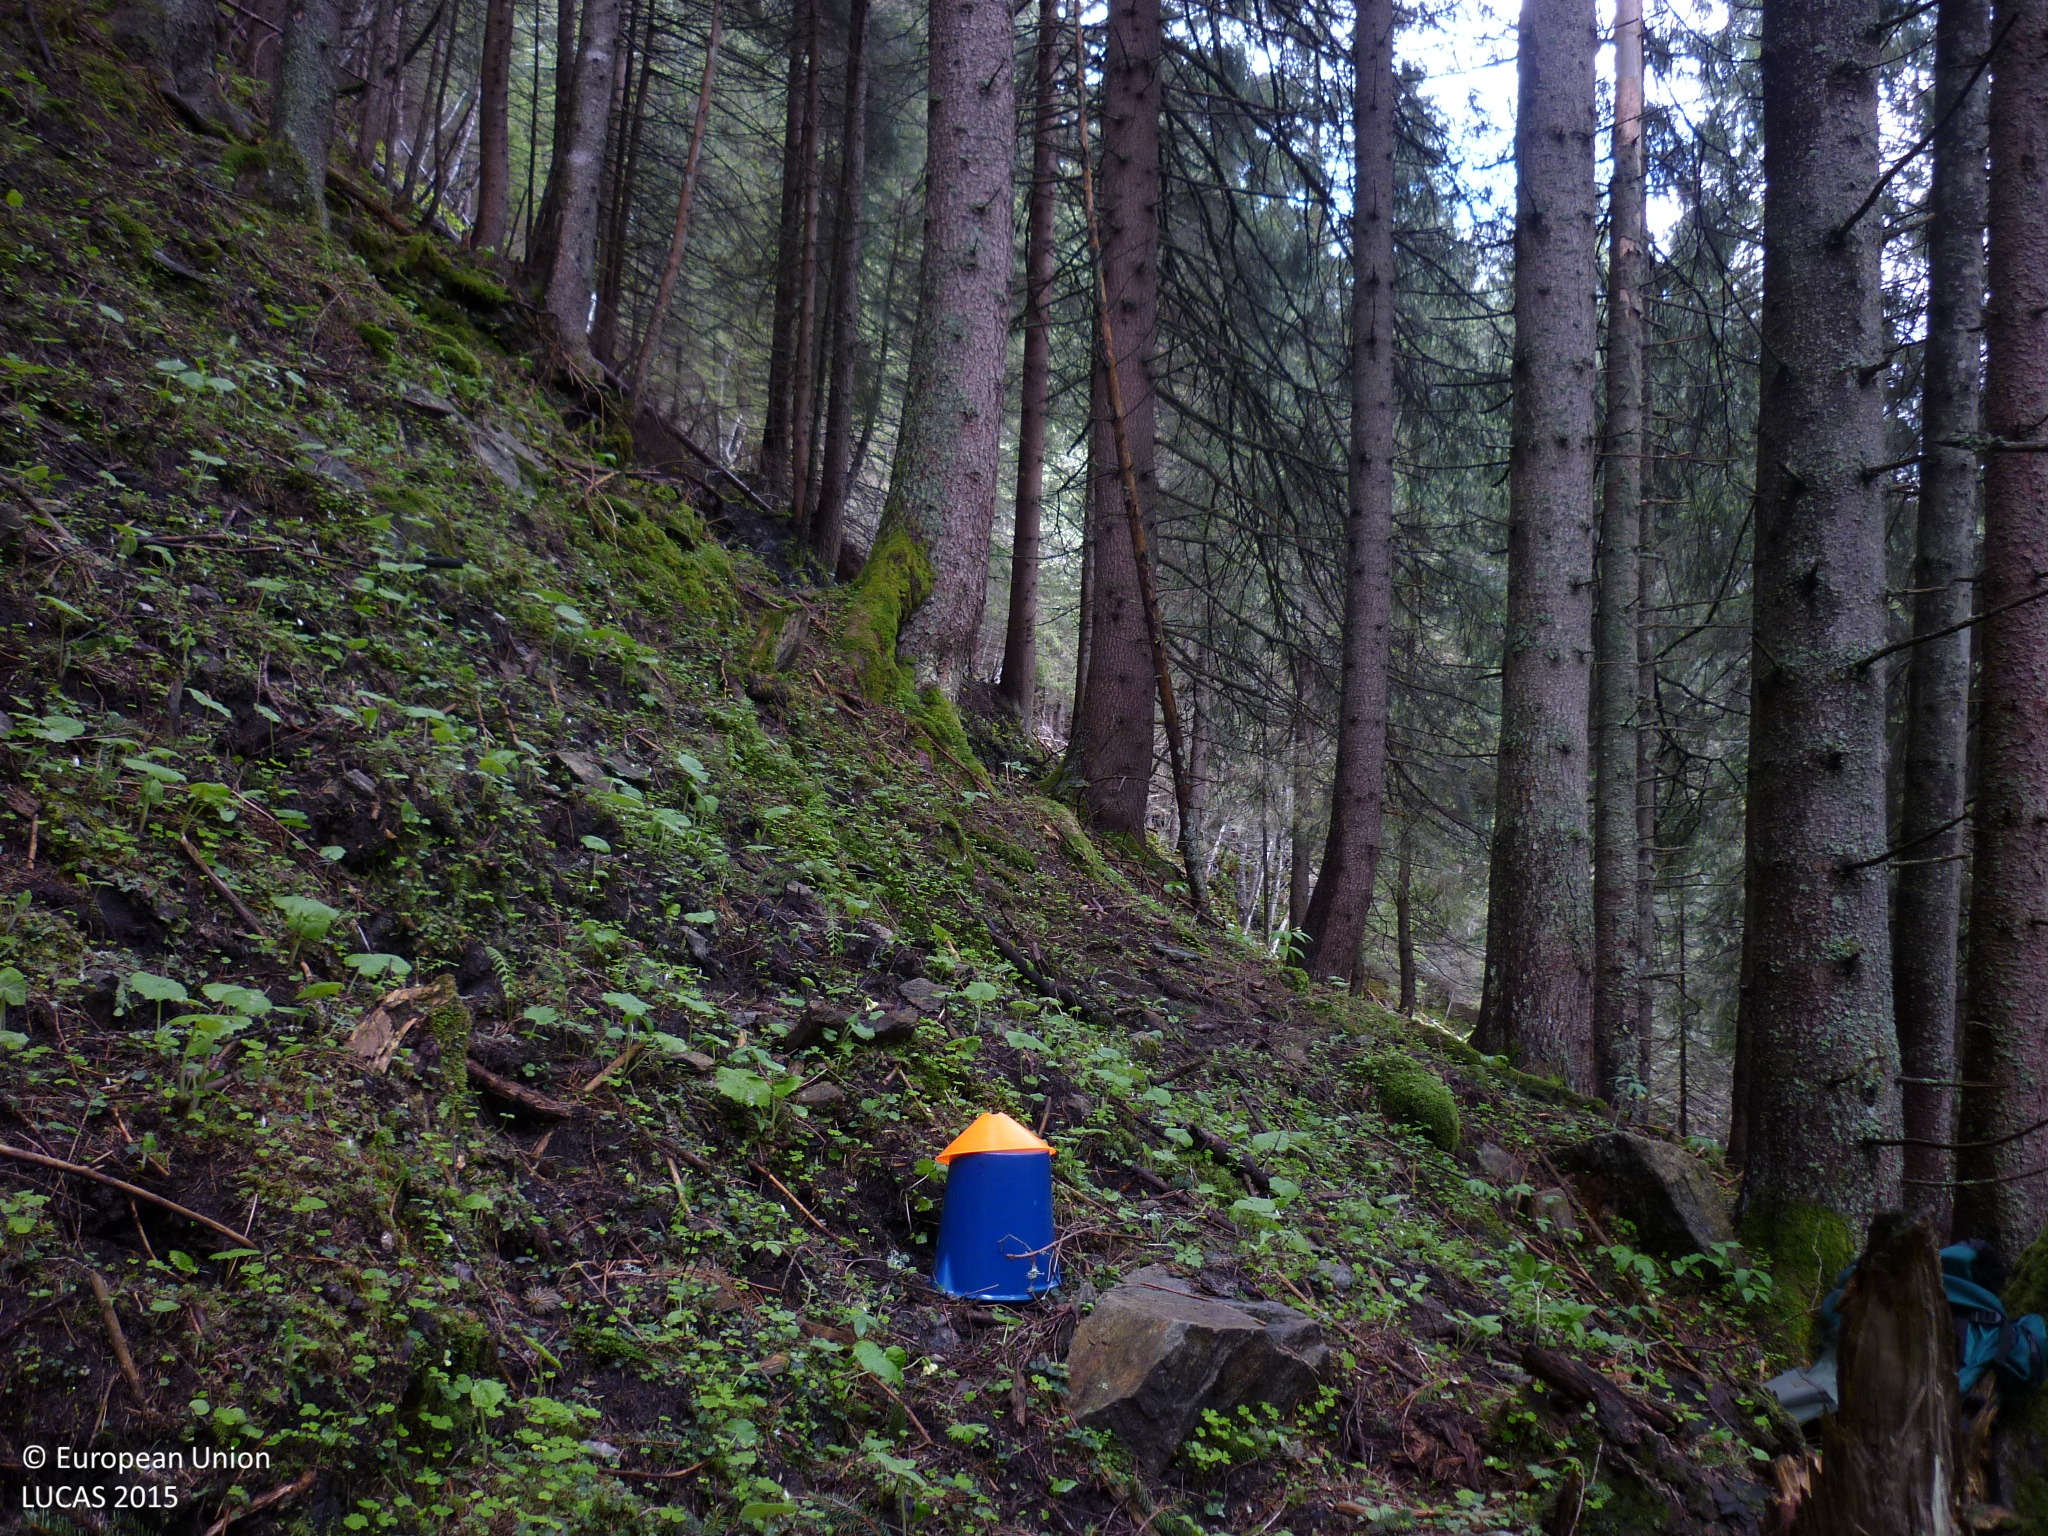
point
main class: Woodland
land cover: Spruce dominated coniferous woodland
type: alpine coniferous forest
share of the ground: > 75 %
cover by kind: coniferous forest trees 85 %, herbaceous plants 5 %, lichens and mosses 5 %, unconsolidated bare surface 5 %
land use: Forestry
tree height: > 5 m
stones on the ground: 10 - 25 %
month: May
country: AT
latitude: 47.3029
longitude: 14.0323
